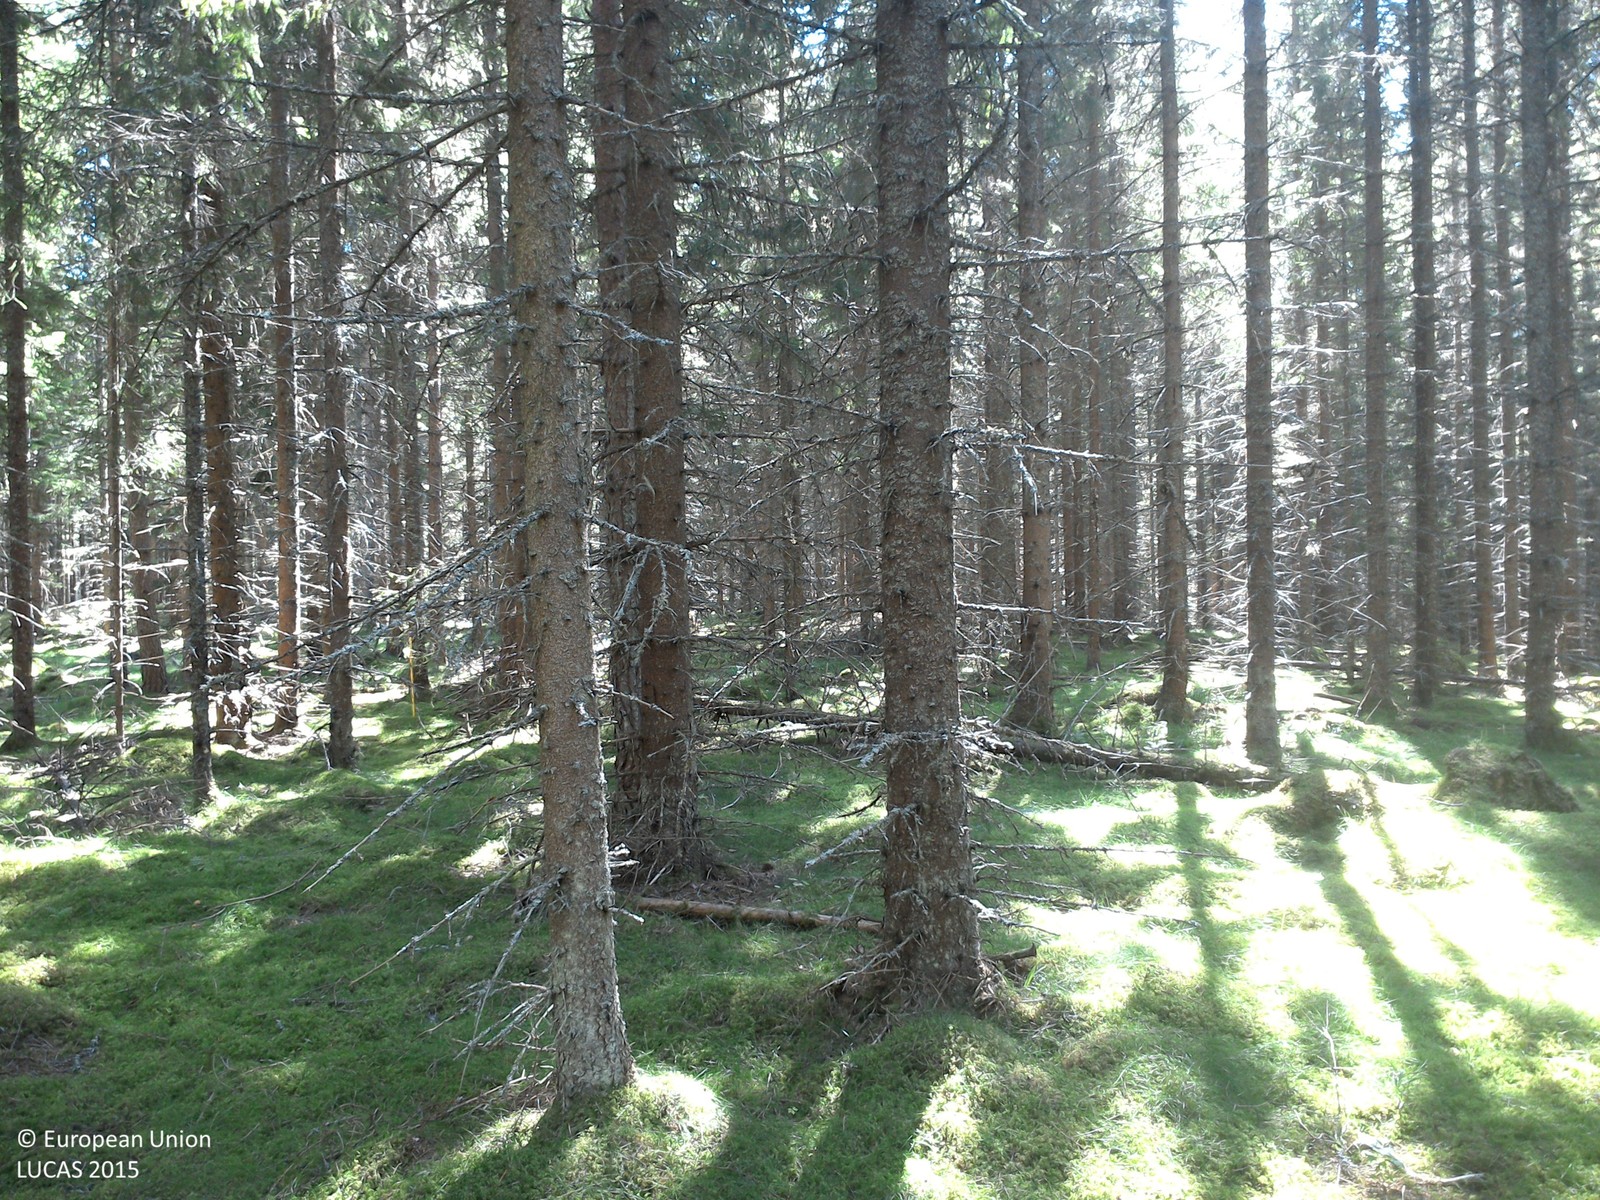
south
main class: Woodland
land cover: Spruce dominated coniferous woodland
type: boreal forest
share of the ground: 50 - 75 %
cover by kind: coniferous forest trees 70 %, lichens and mosses 30 %
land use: Forestry
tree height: > 5 m
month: August
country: SE
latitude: 57.9467
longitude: 15.4524
